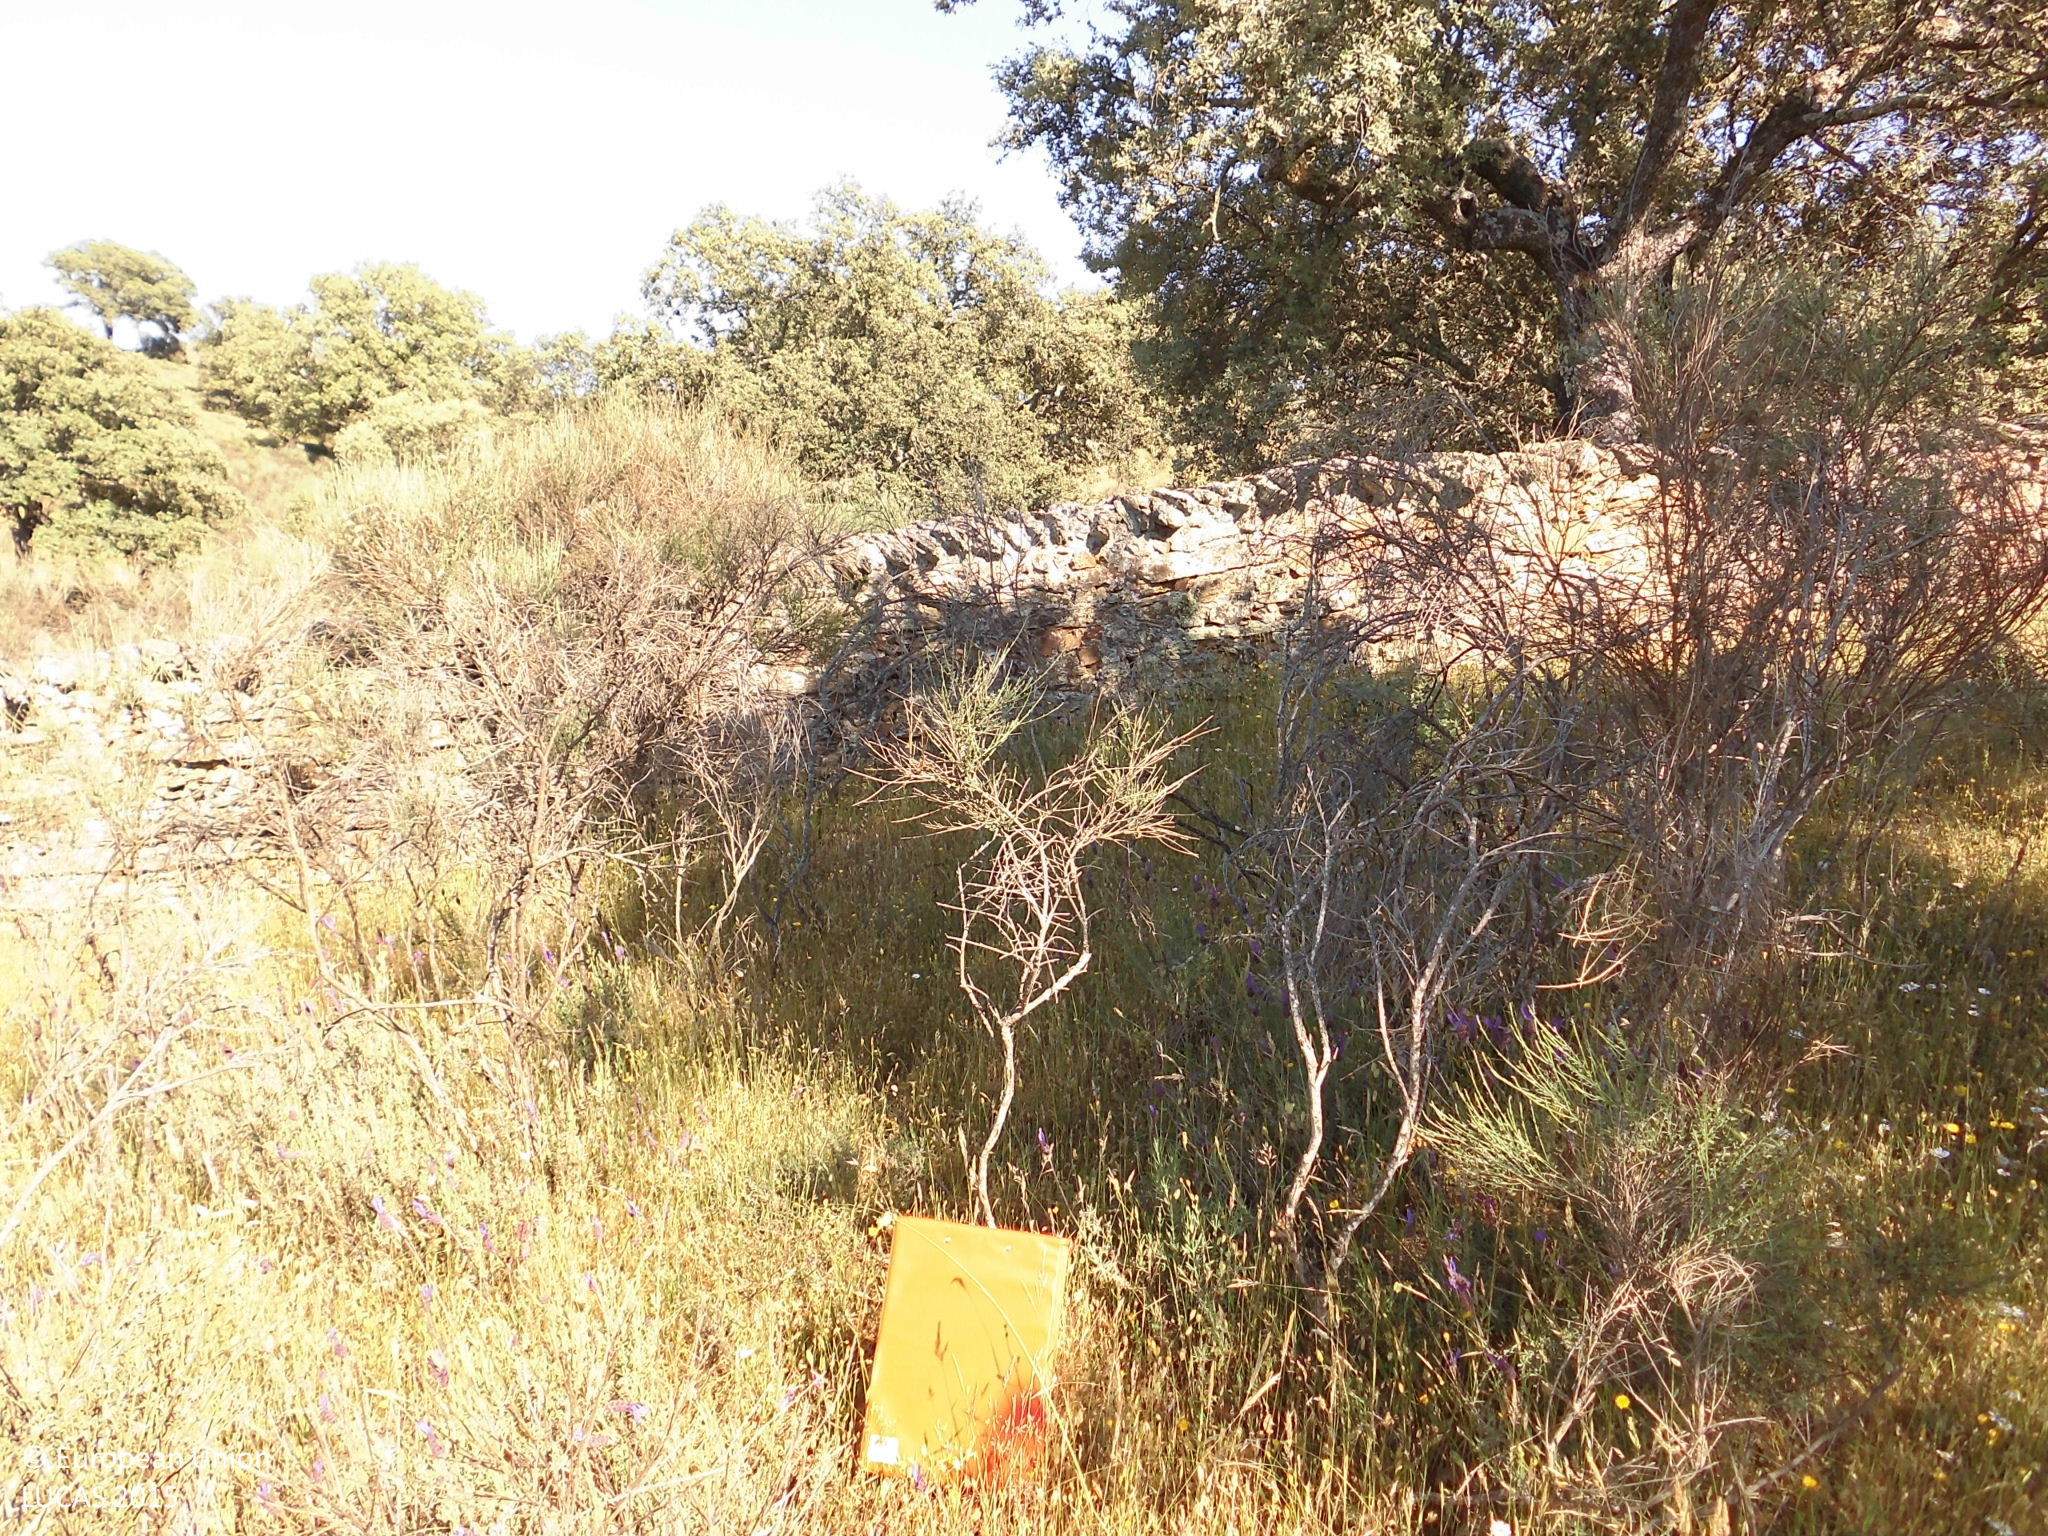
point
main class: Woodland
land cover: Broadleaved woodland
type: broadleaved evergreen forest
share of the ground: 25 - 50 %
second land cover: Shrubland without tree cover
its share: > 75 %
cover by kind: herbaceous plants 50 %, broadleaved forest trees 30 %, shrubs 20 %
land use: Forestry
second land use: Agriculture (excluding fallow land and kitchen gardens)
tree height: > 5 m
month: May
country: ES
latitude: 39.5339
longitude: -6.1078
